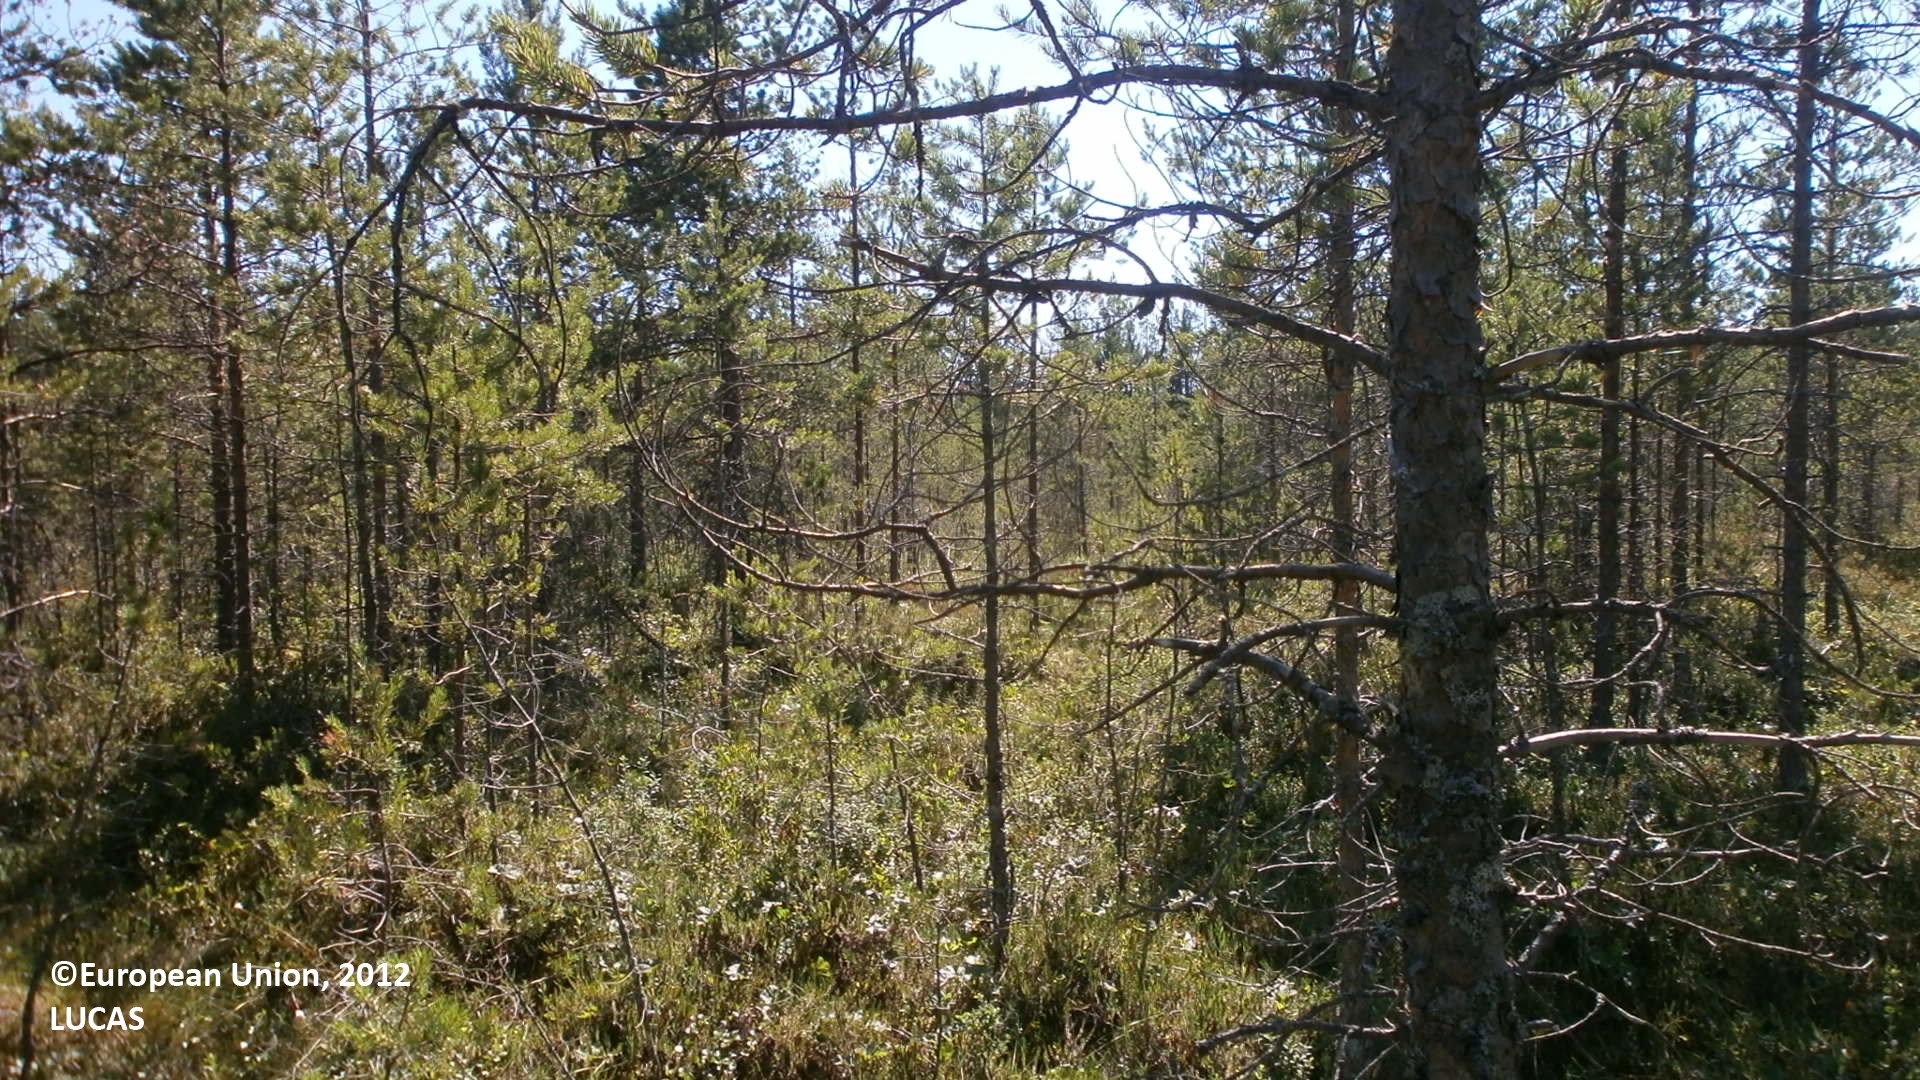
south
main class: Woodland
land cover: Pine dominated coniferous woodland
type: mire and swamp forests
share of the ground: 25 - 50 %
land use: Forestry
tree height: > 5 m
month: July
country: FI
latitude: 64.1720
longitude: 23.8653
